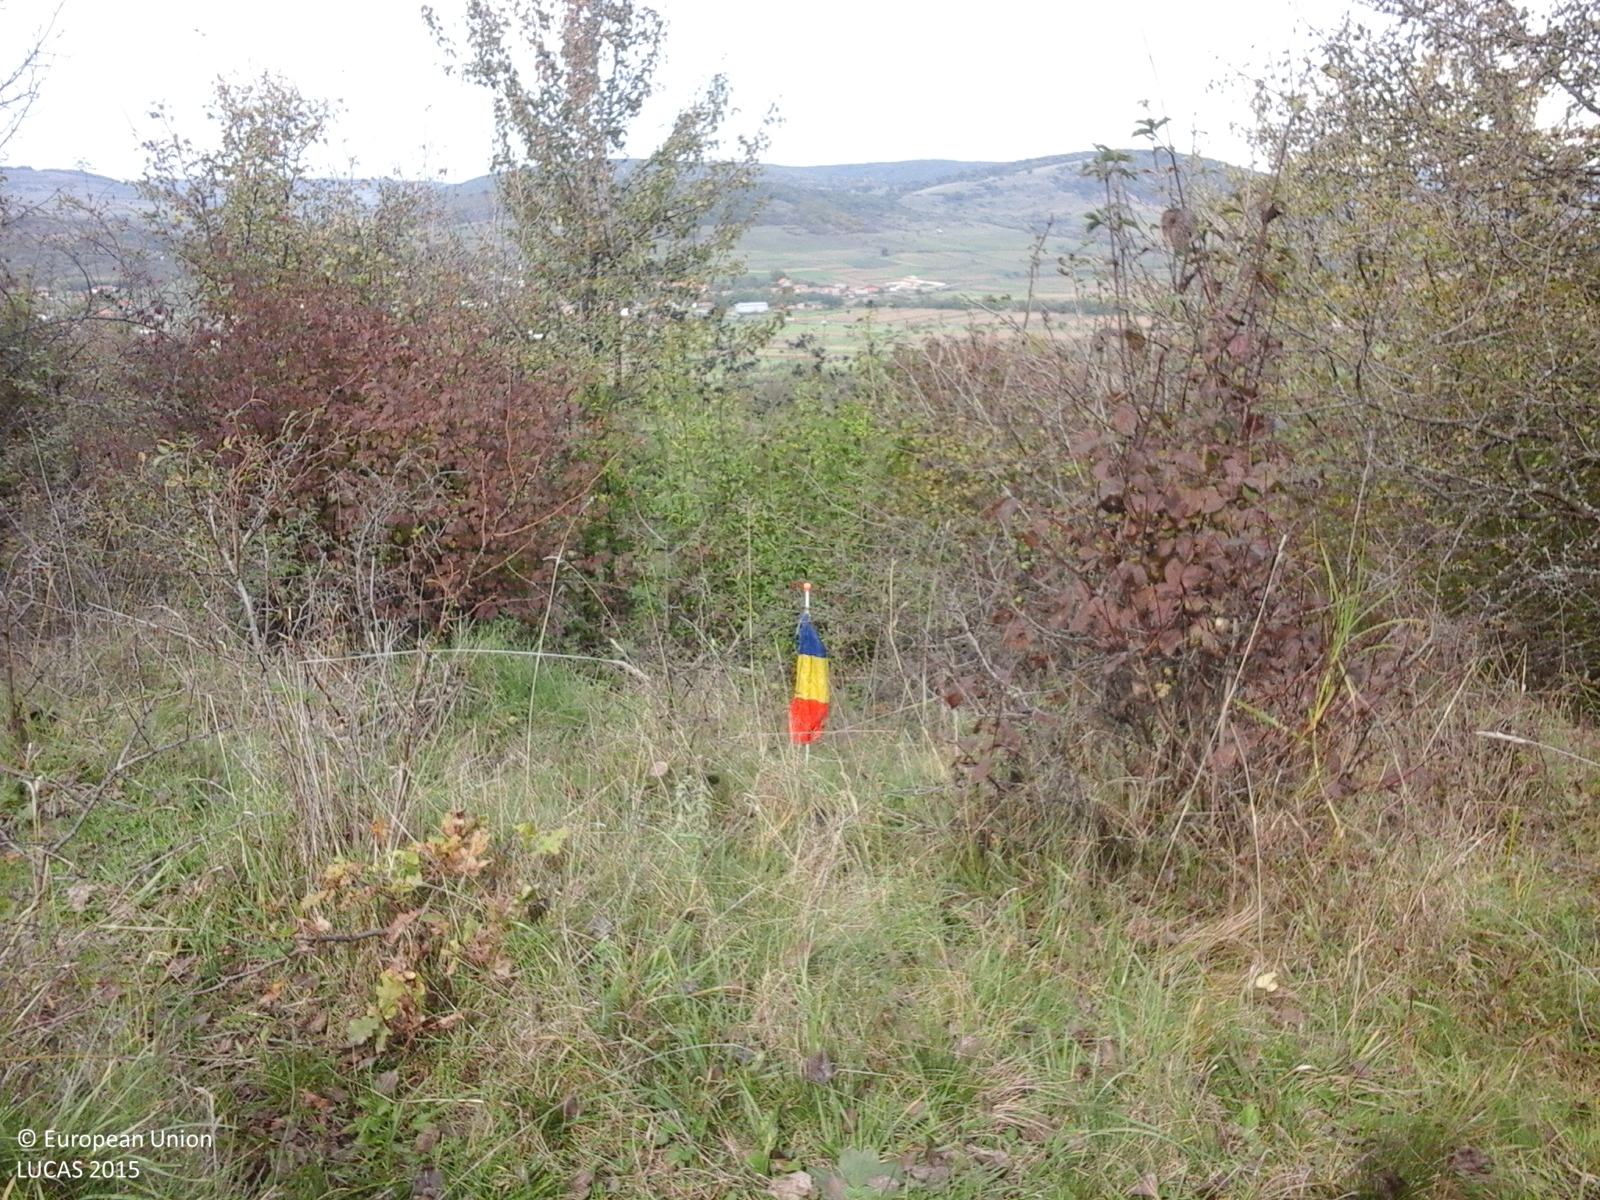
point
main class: Shrubland
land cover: Shrubland with sparse tree cover
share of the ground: > 75 %
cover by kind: herbaceous plants 60 %, shrubs 35 %, broadleaved forest trees 5 %
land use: Fallow land
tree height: < 5 m
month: October
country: RO
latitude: 46.2548
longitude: 25.2659
